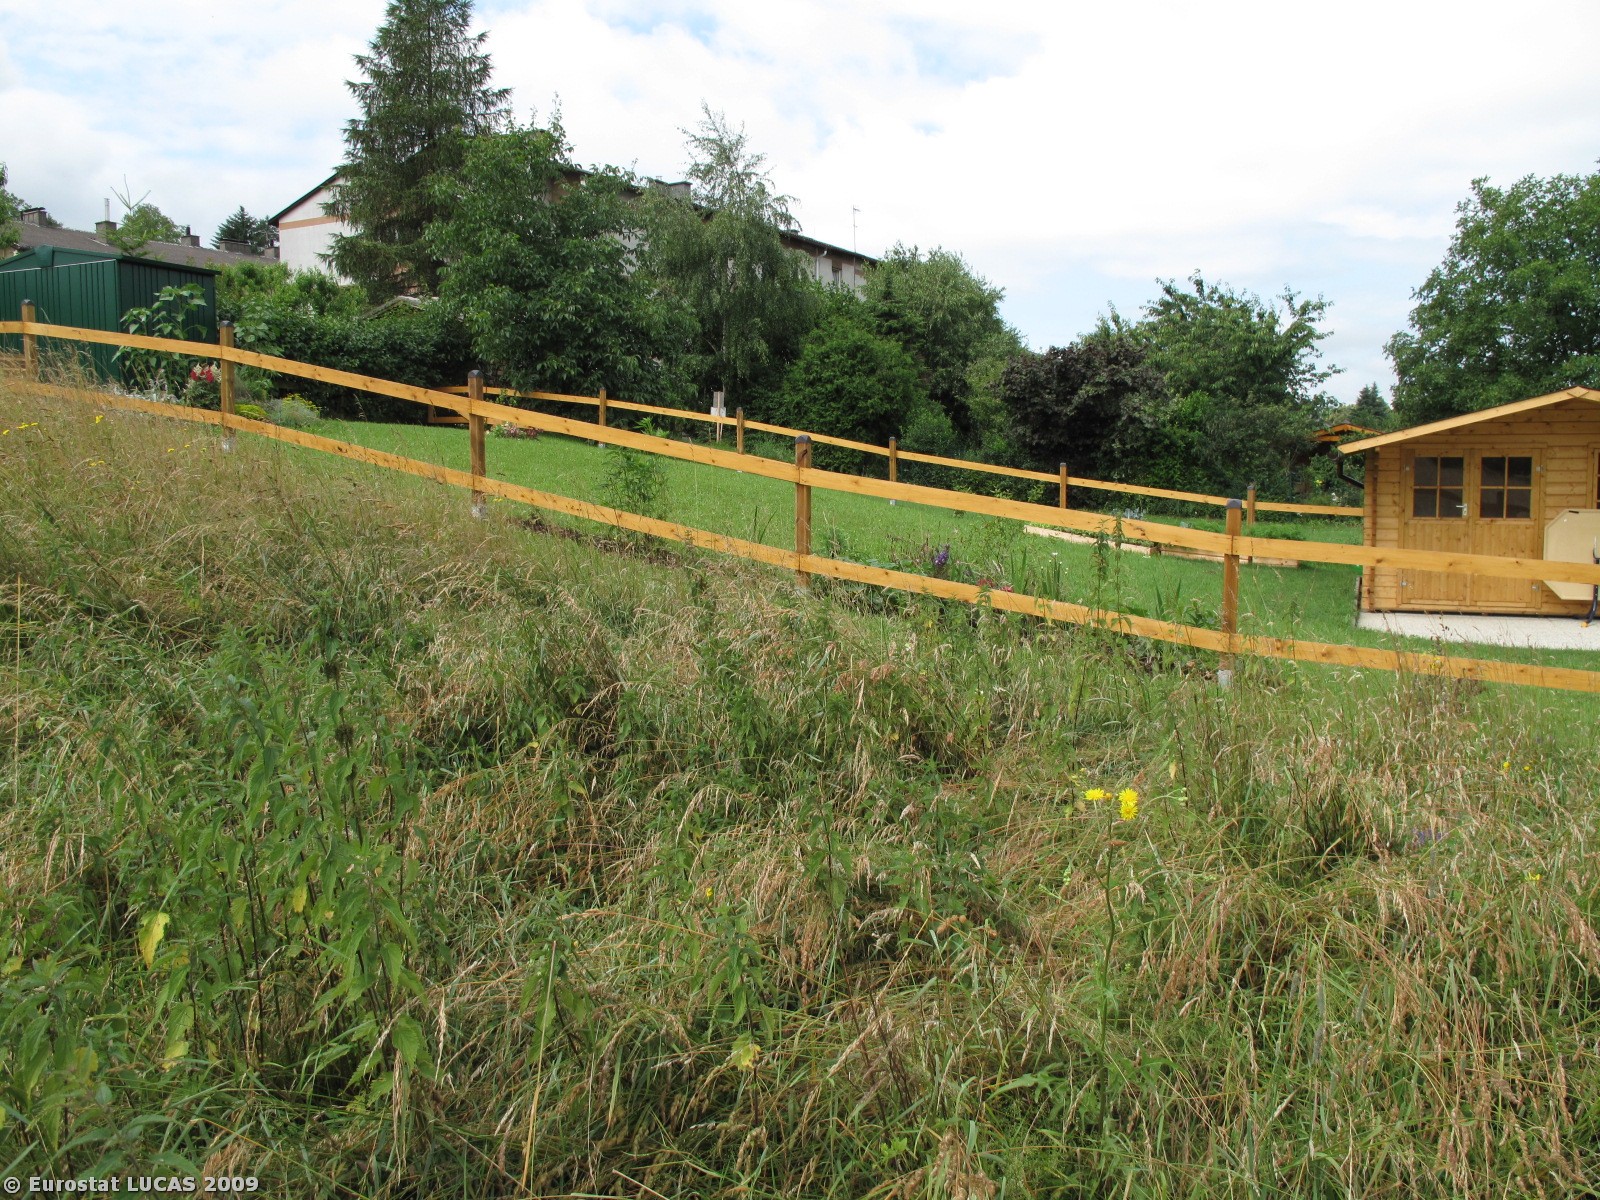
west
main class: Grassland
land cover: Grassland without tree/shrub cover
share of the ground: > 75 %
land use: Unused
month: June
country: AT
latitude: 48.1899
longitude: 15.9358
